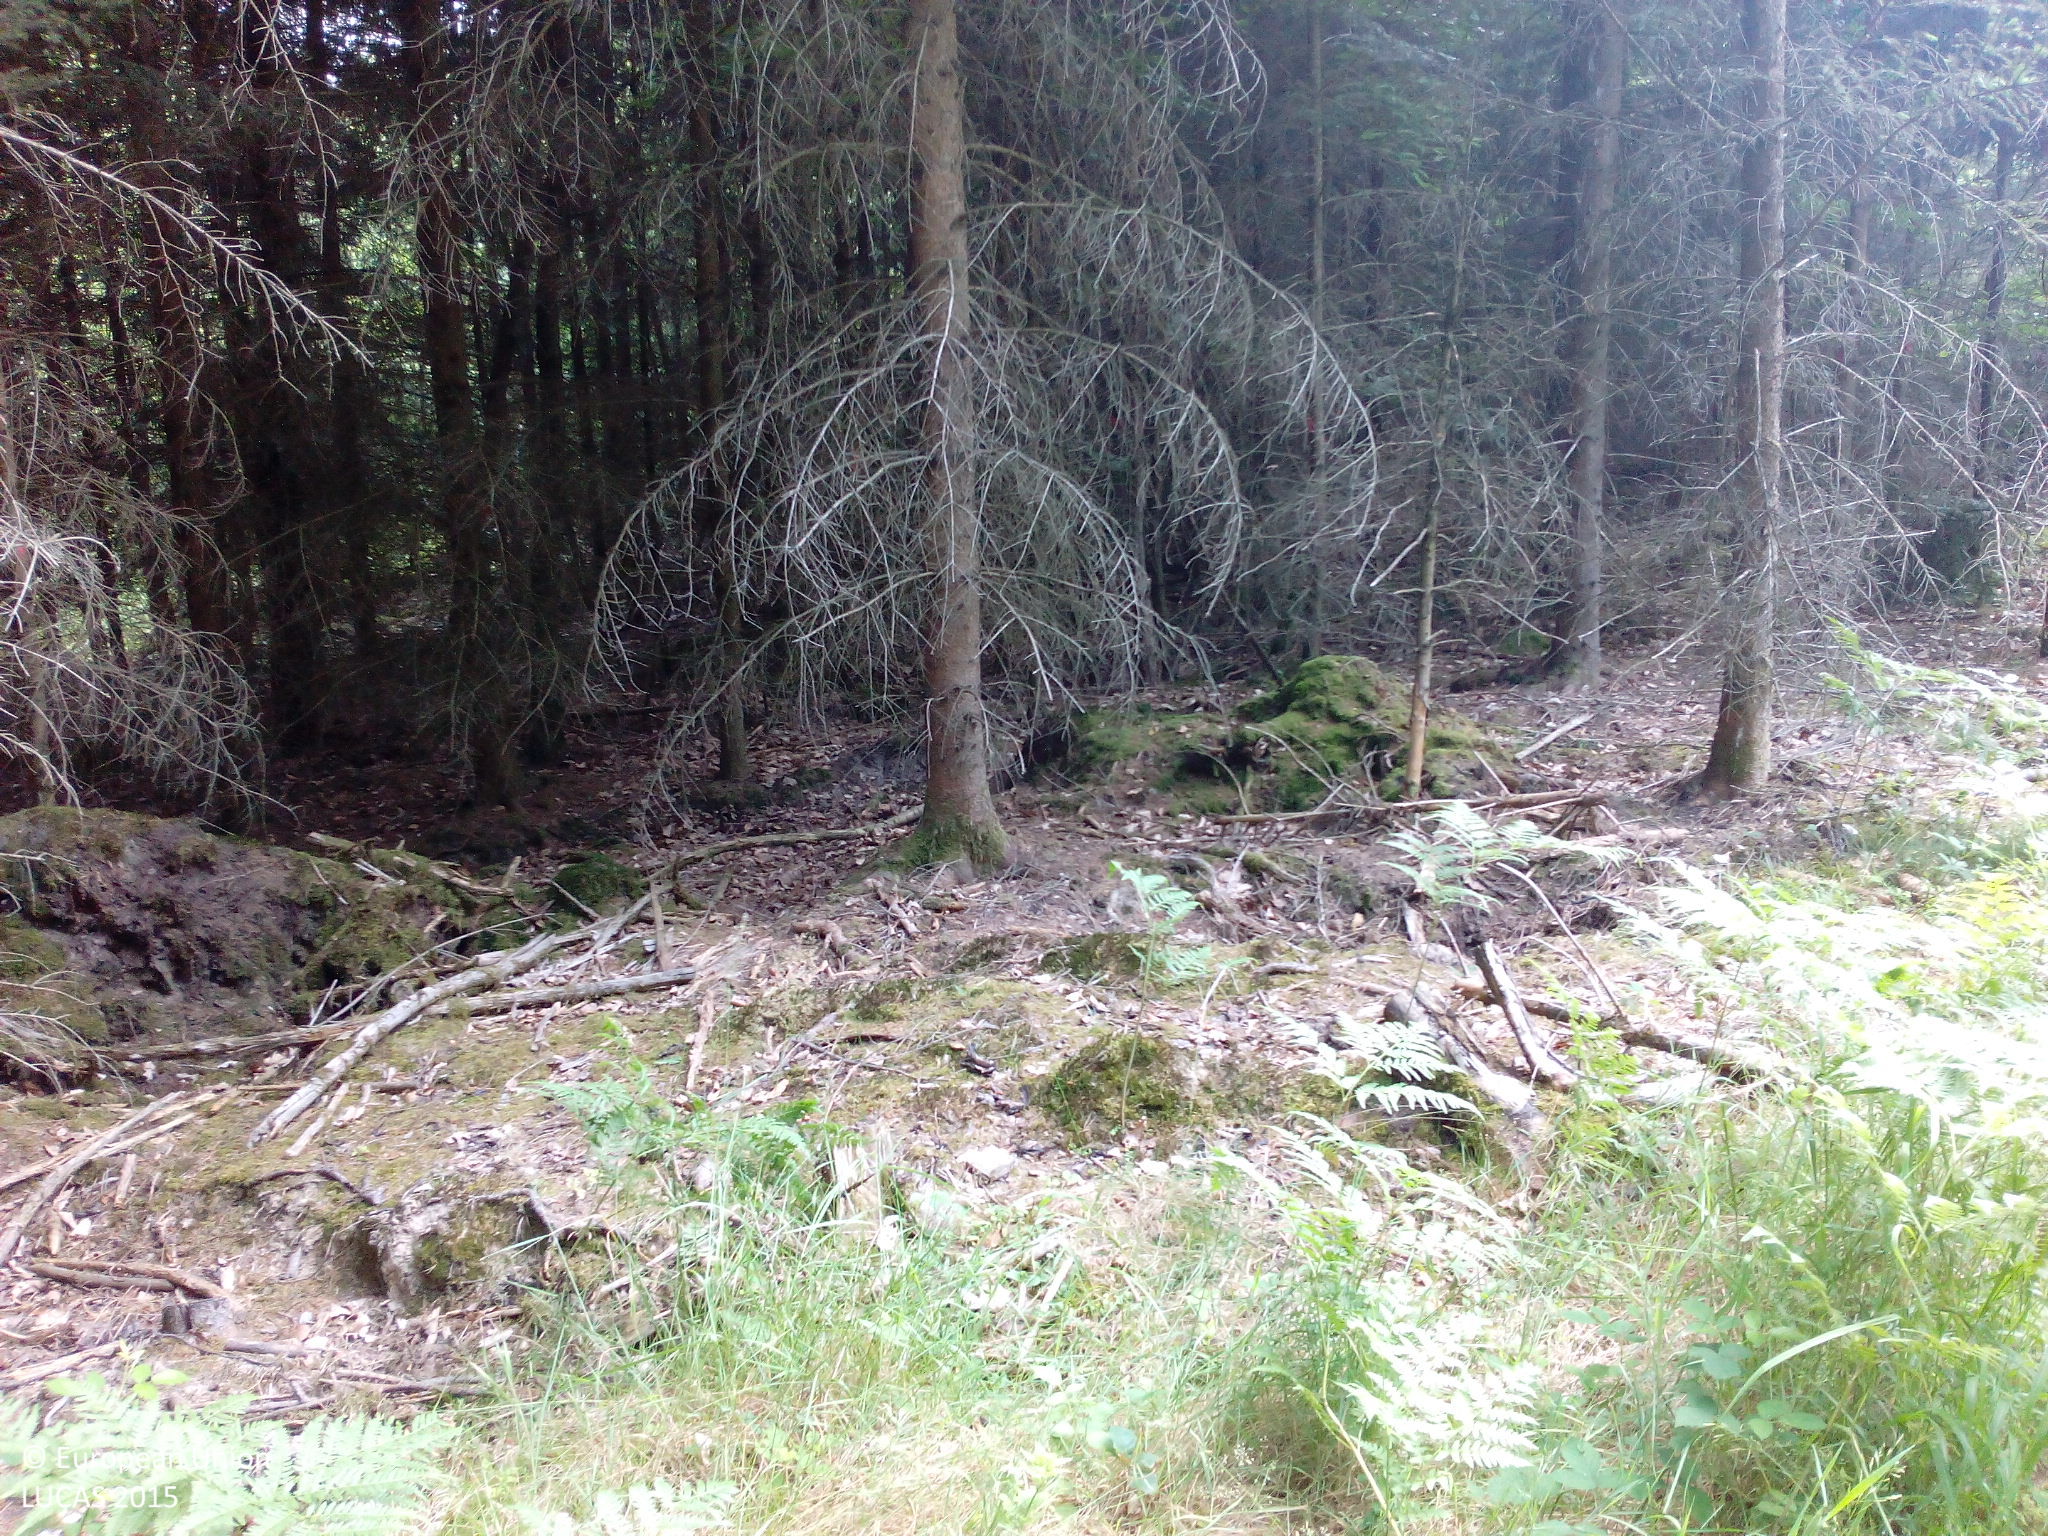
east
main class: Woodland
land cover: Spruce dominated coniferous woodland
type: hemiboreal forest and nemoral coniferous forest and mixed broadleaved-coniferous forest
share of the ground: > 75 %
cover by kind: coniferous forest trees 95 %, consolidated bare surface 5 %
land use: Forestry
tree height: > 5 m
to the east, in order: Tracks; Spruce dominated coniferous woodland; Tracks; Other mixed woodland; Other coniferous woodland; Tracks; Spruce dominated coniferous woodland; Grass margins; Maize
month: July
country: DE
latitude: 48.9057
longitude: 12.0867
